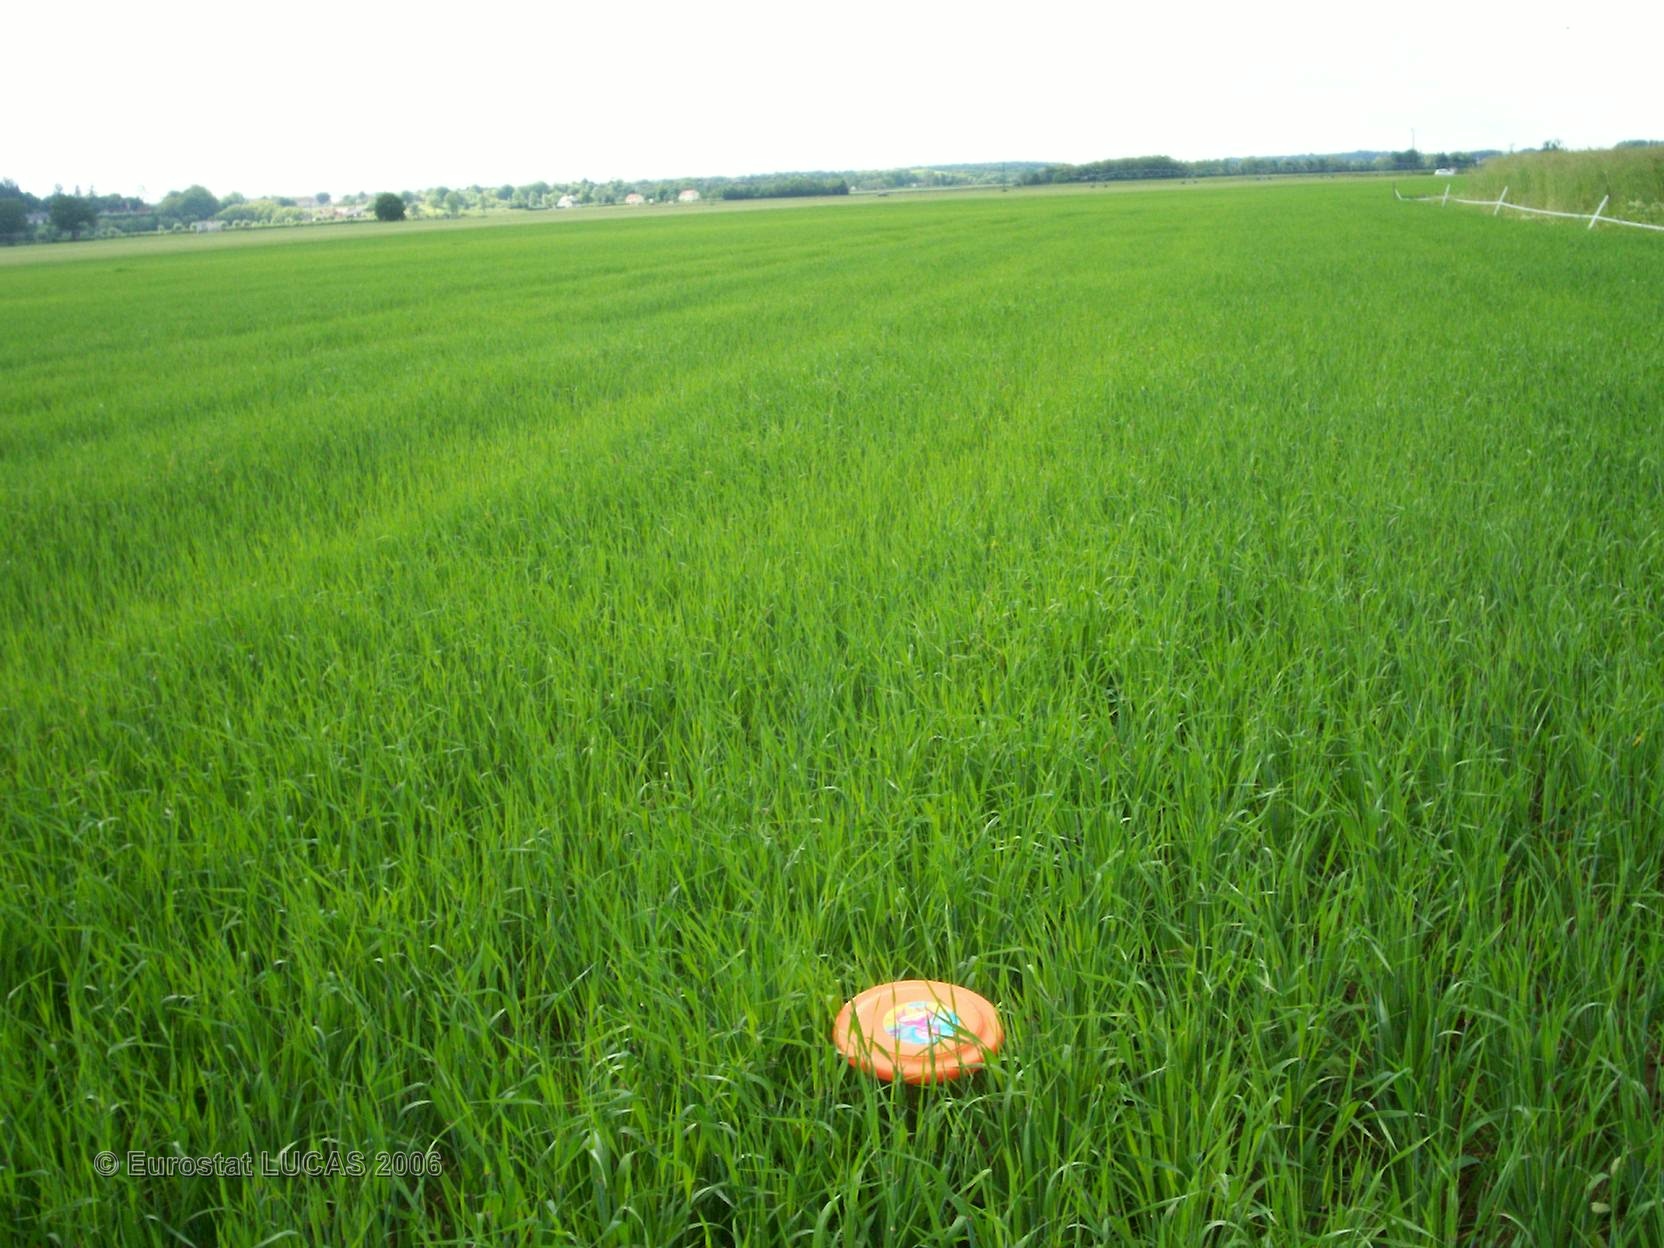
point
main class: Cropland
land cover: Barley
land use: Agriculture (excluding fallow land and kitchen gardens)
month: June
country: FR
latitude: 47.1172
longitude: 3.0232
